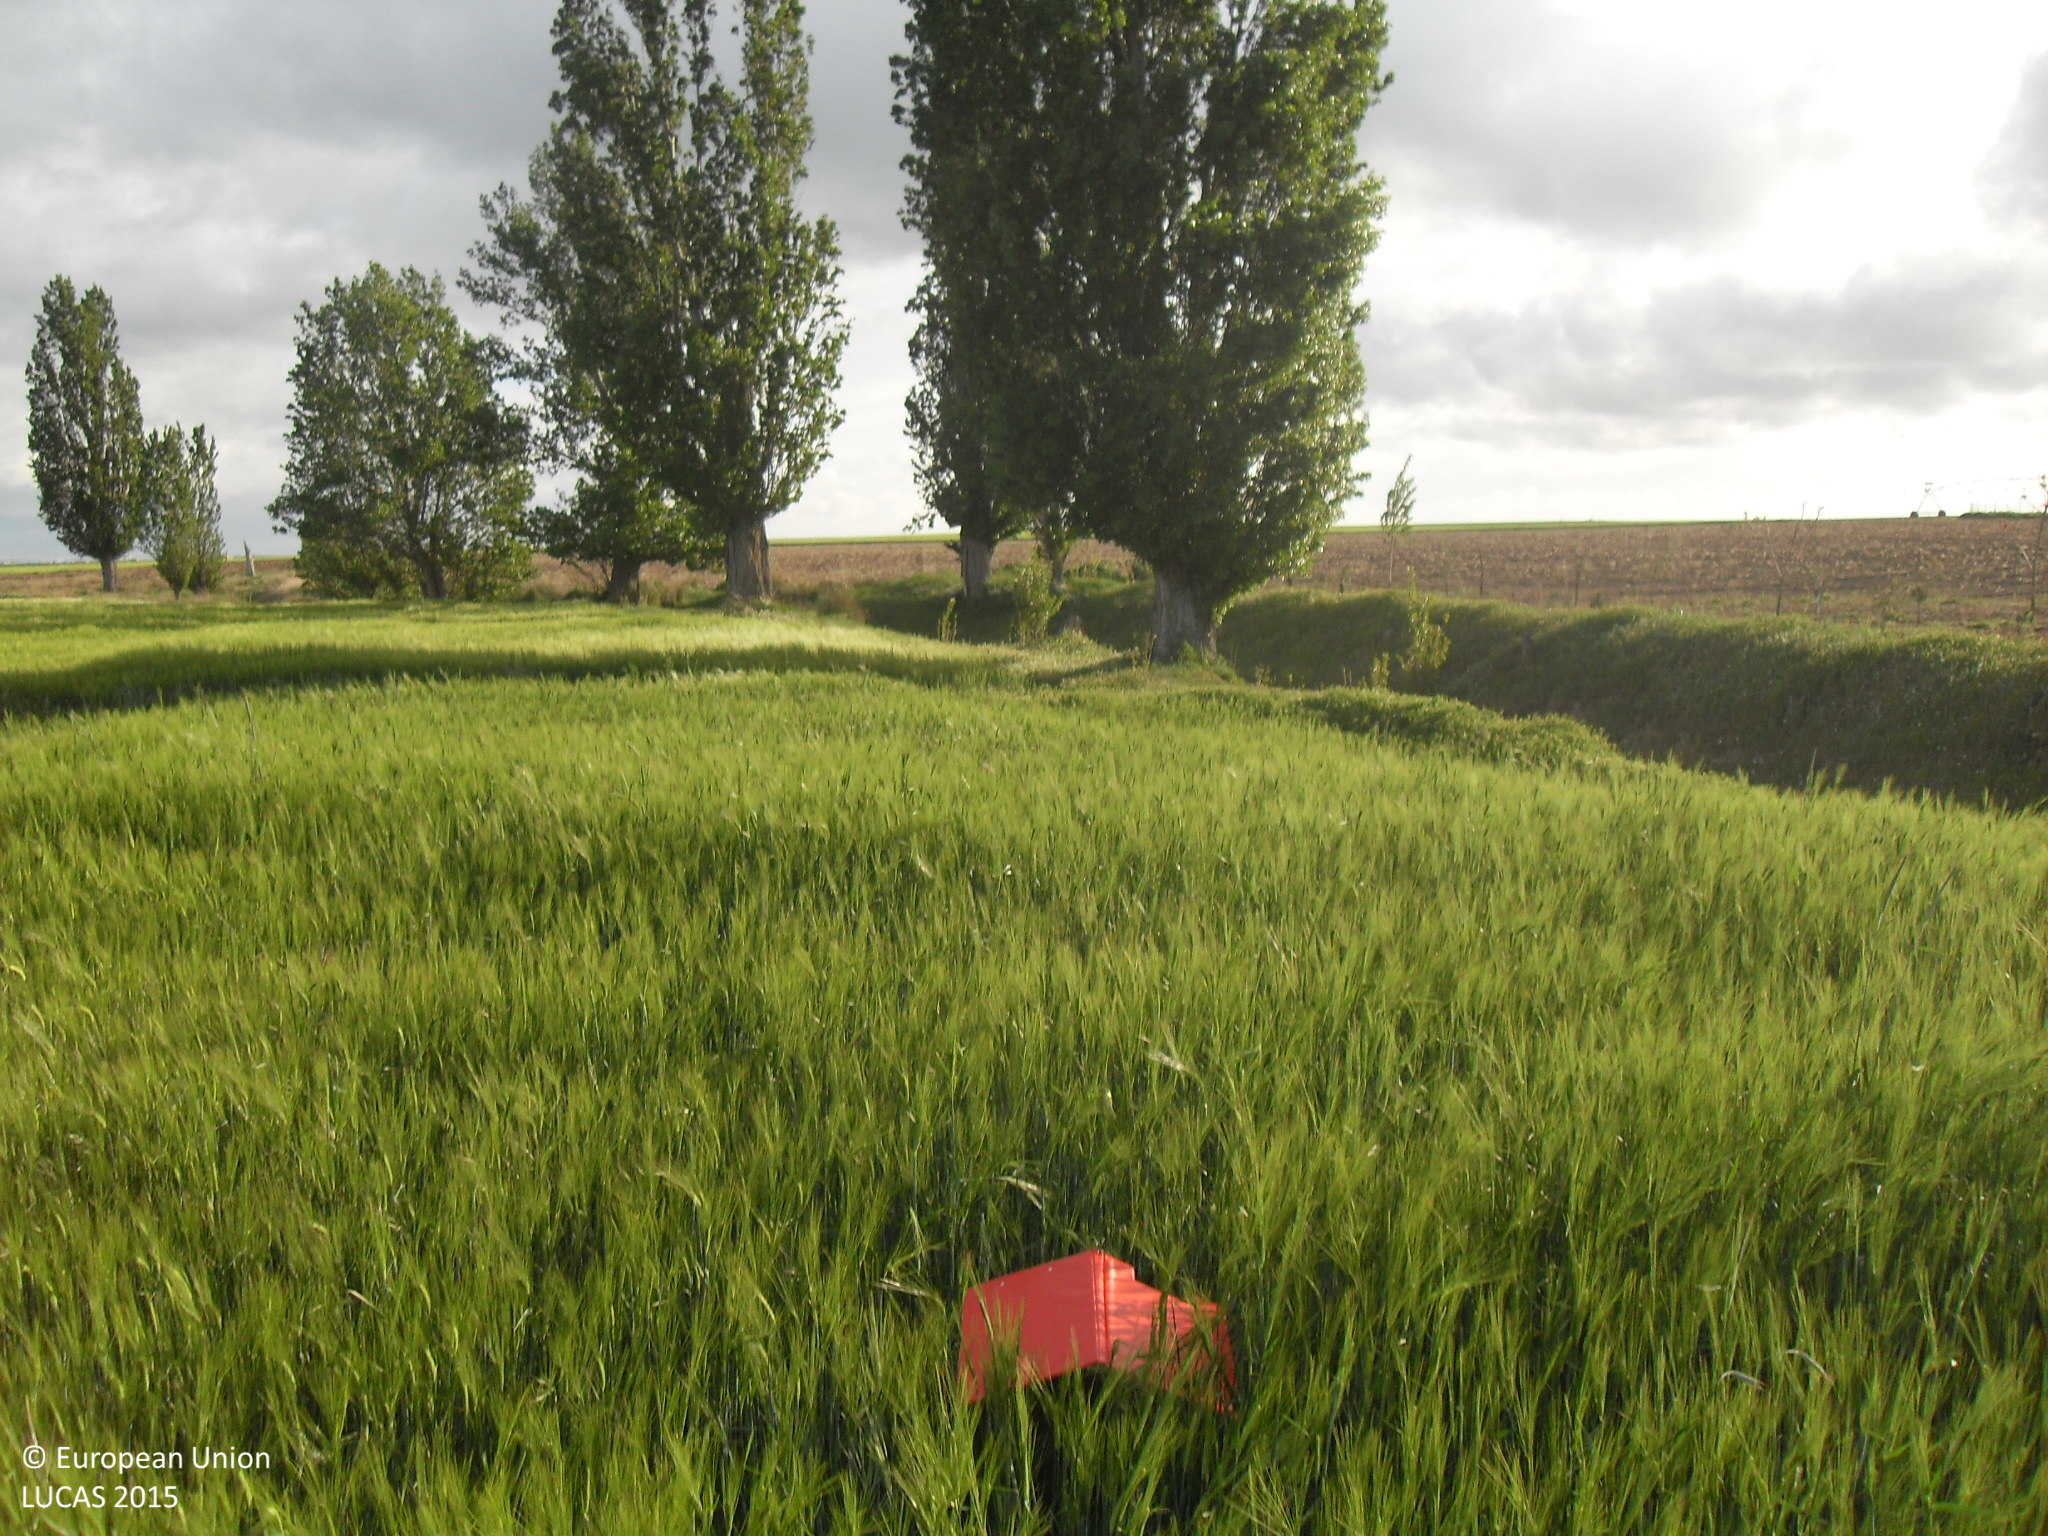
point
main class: Cropland
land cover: Barley
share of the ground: > 75 %
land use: Agriculture (excluding fallow land and kitchen gardens)
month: May
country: ES
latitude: 40.9713
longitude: -5.1718
